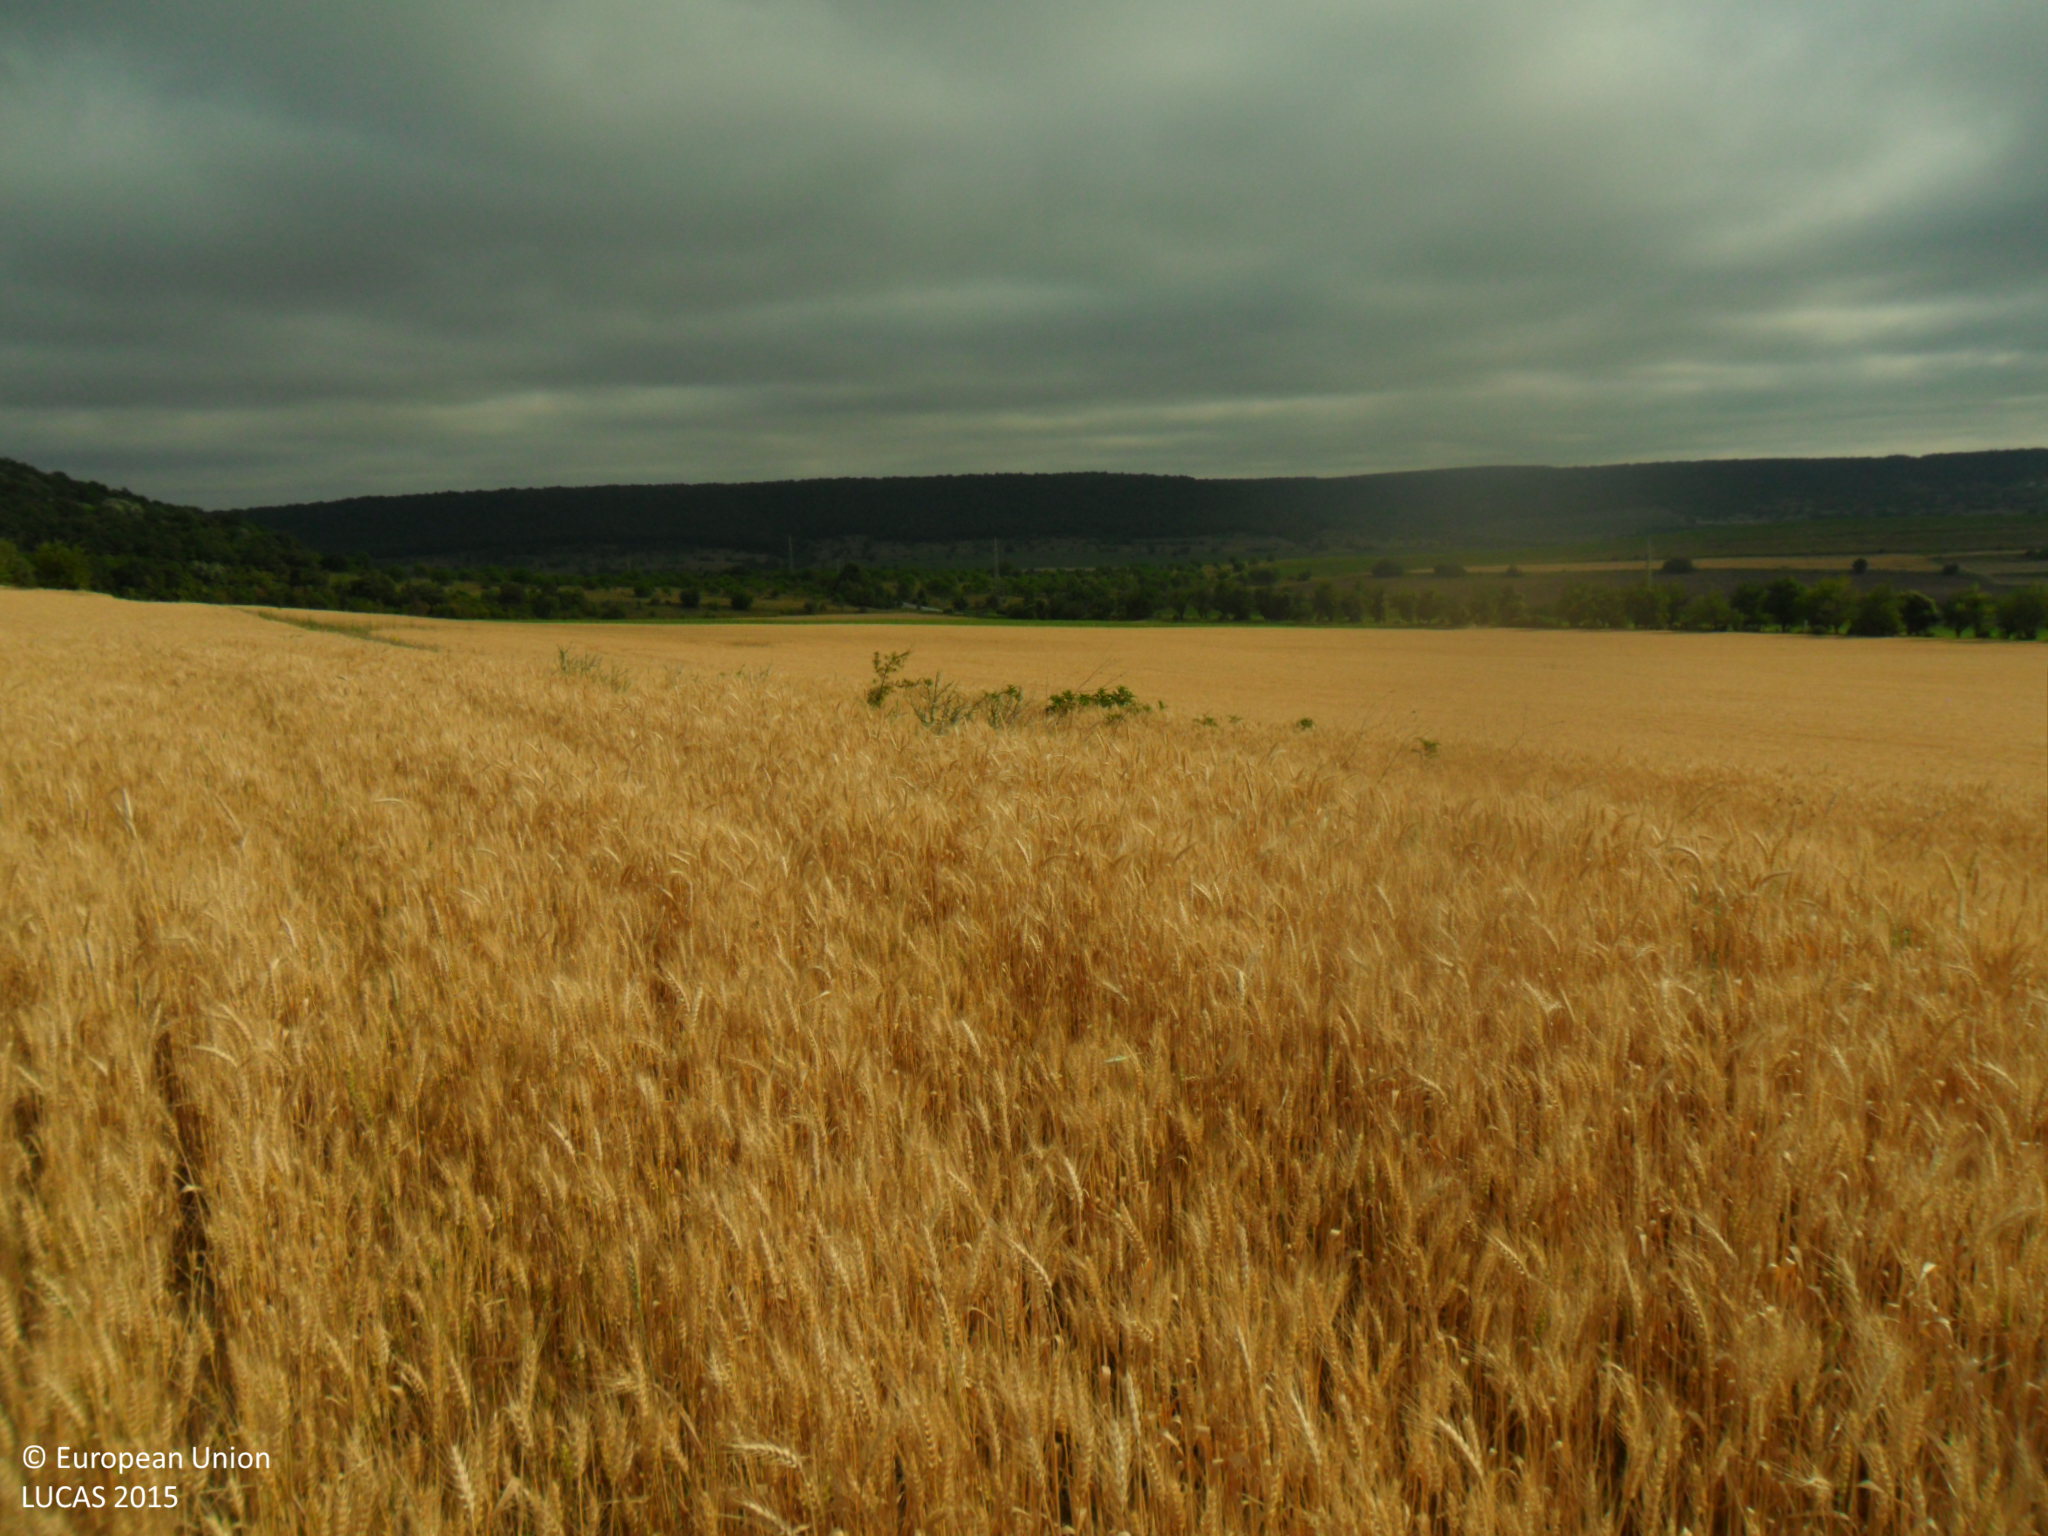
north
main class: Cropland
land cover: Common wheat
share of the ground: > 75 %
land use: Agriculture (excluding fallow land and kitchen gardens)
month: June
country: BG
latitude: 43.4852
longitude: 27.1216
